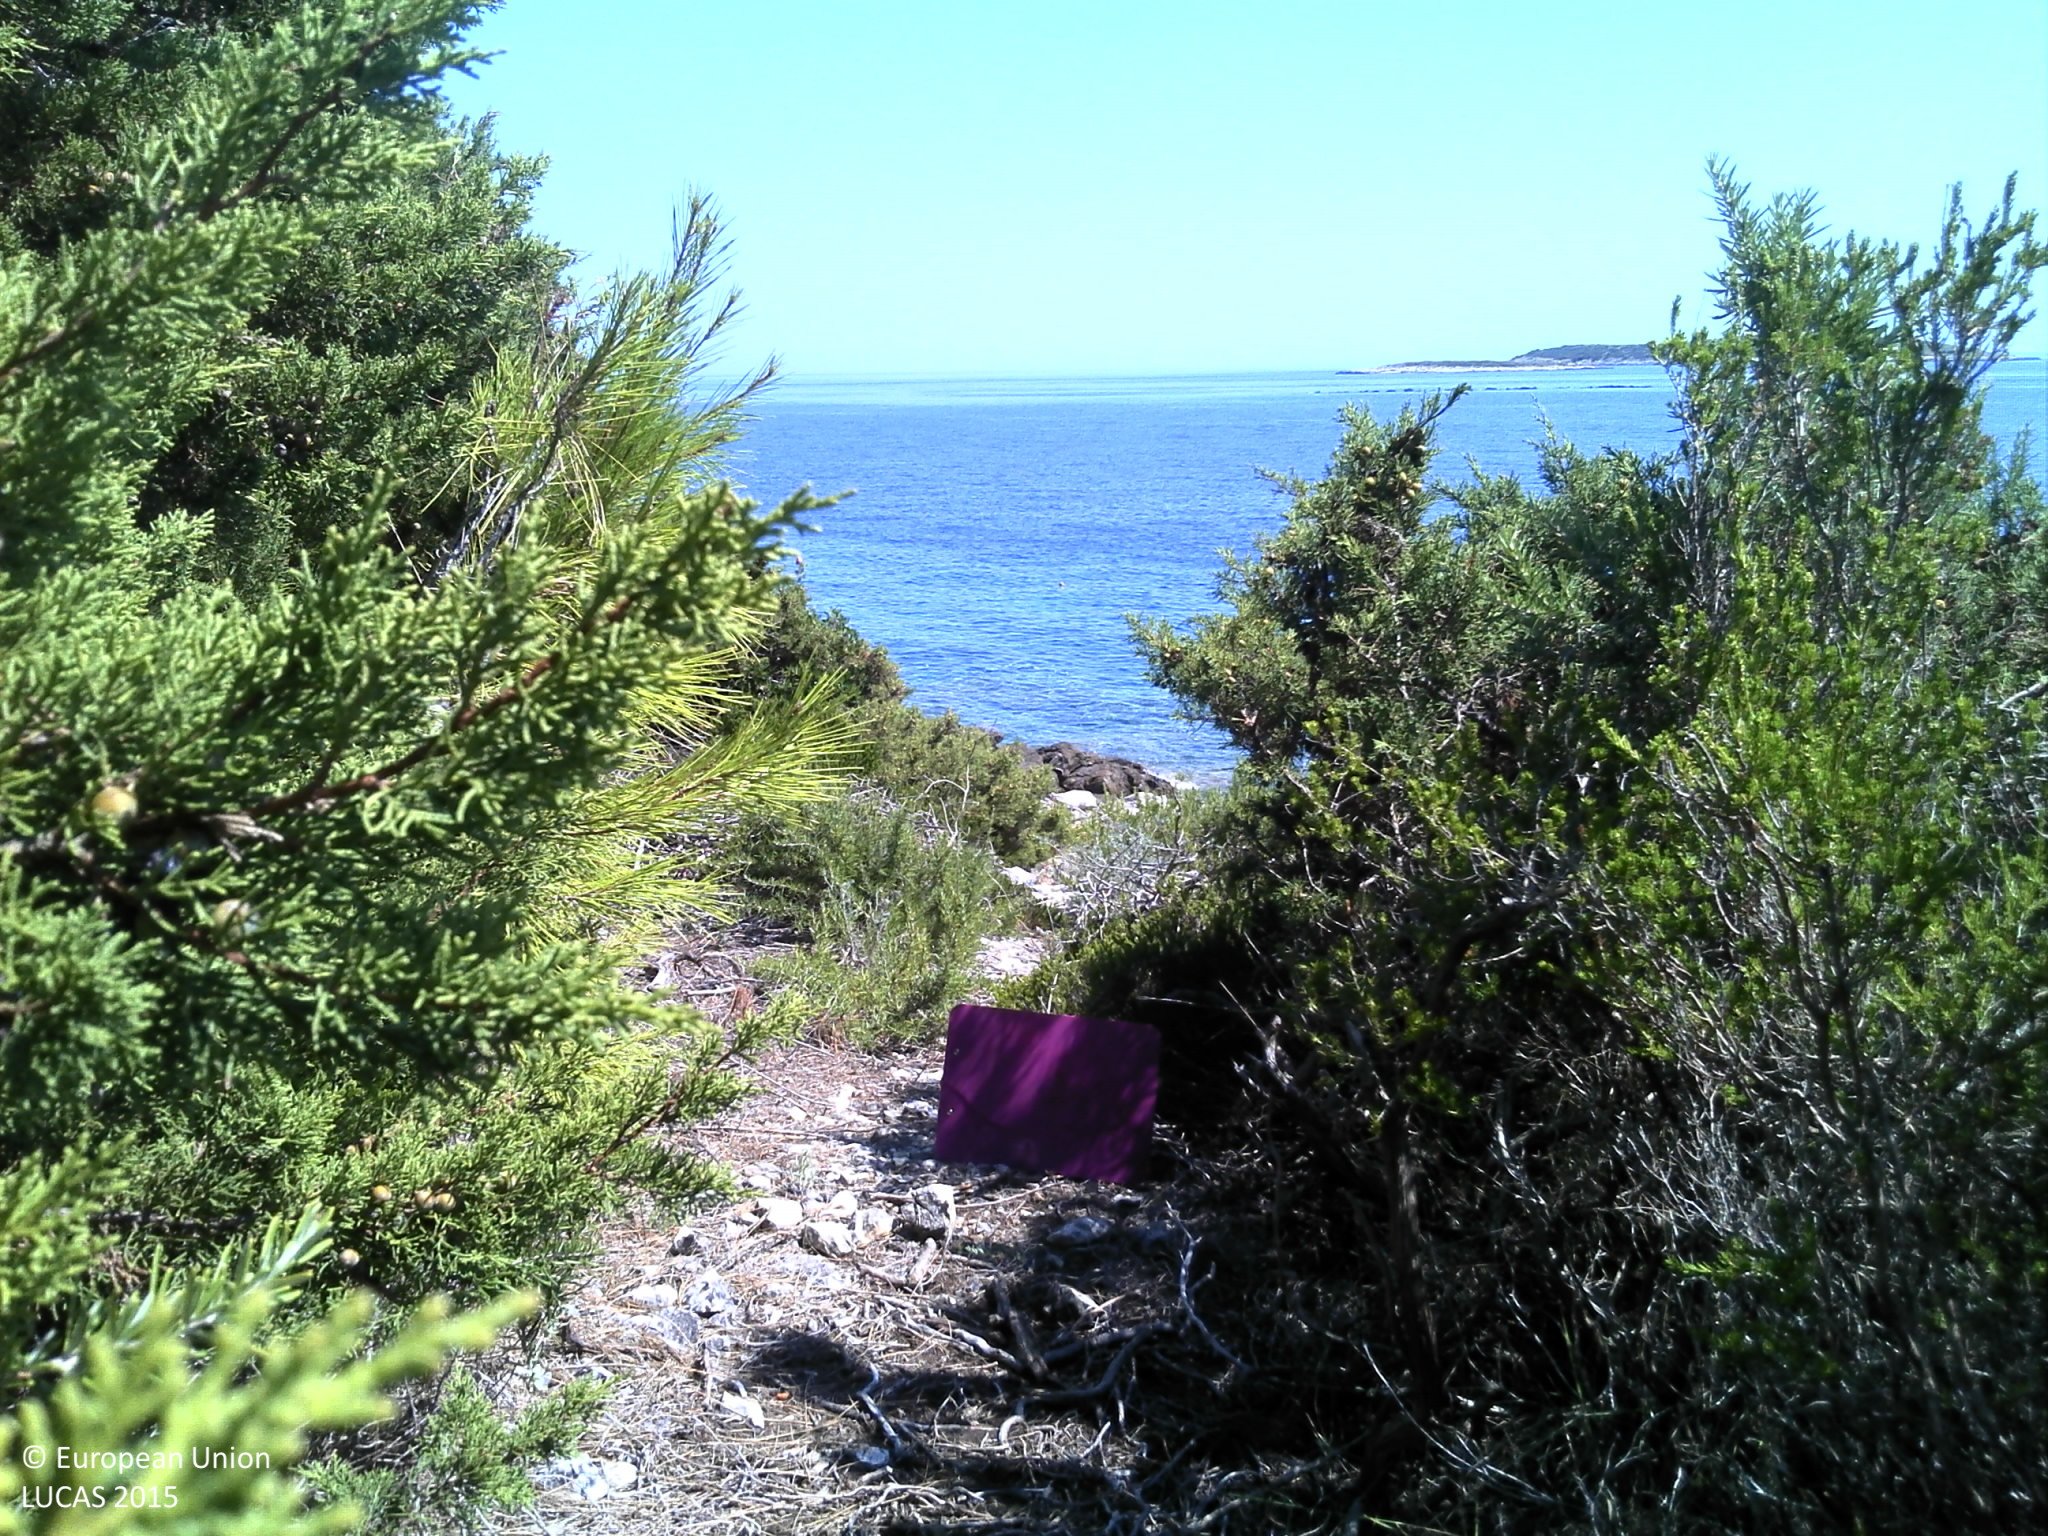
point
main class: Shrubland
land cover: Shrubland with sparse tree cover
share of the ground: > 75 %
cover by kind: shrubs 70 %, unconsolidated bare surface 15 %, coniferous forest trees 5 %, herbaceous plants 5 %, consolidated bare surface 5 %
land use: Semi-natural and natural areas not in use
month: August
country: HR
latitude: 43.0411
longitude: 16.2365
